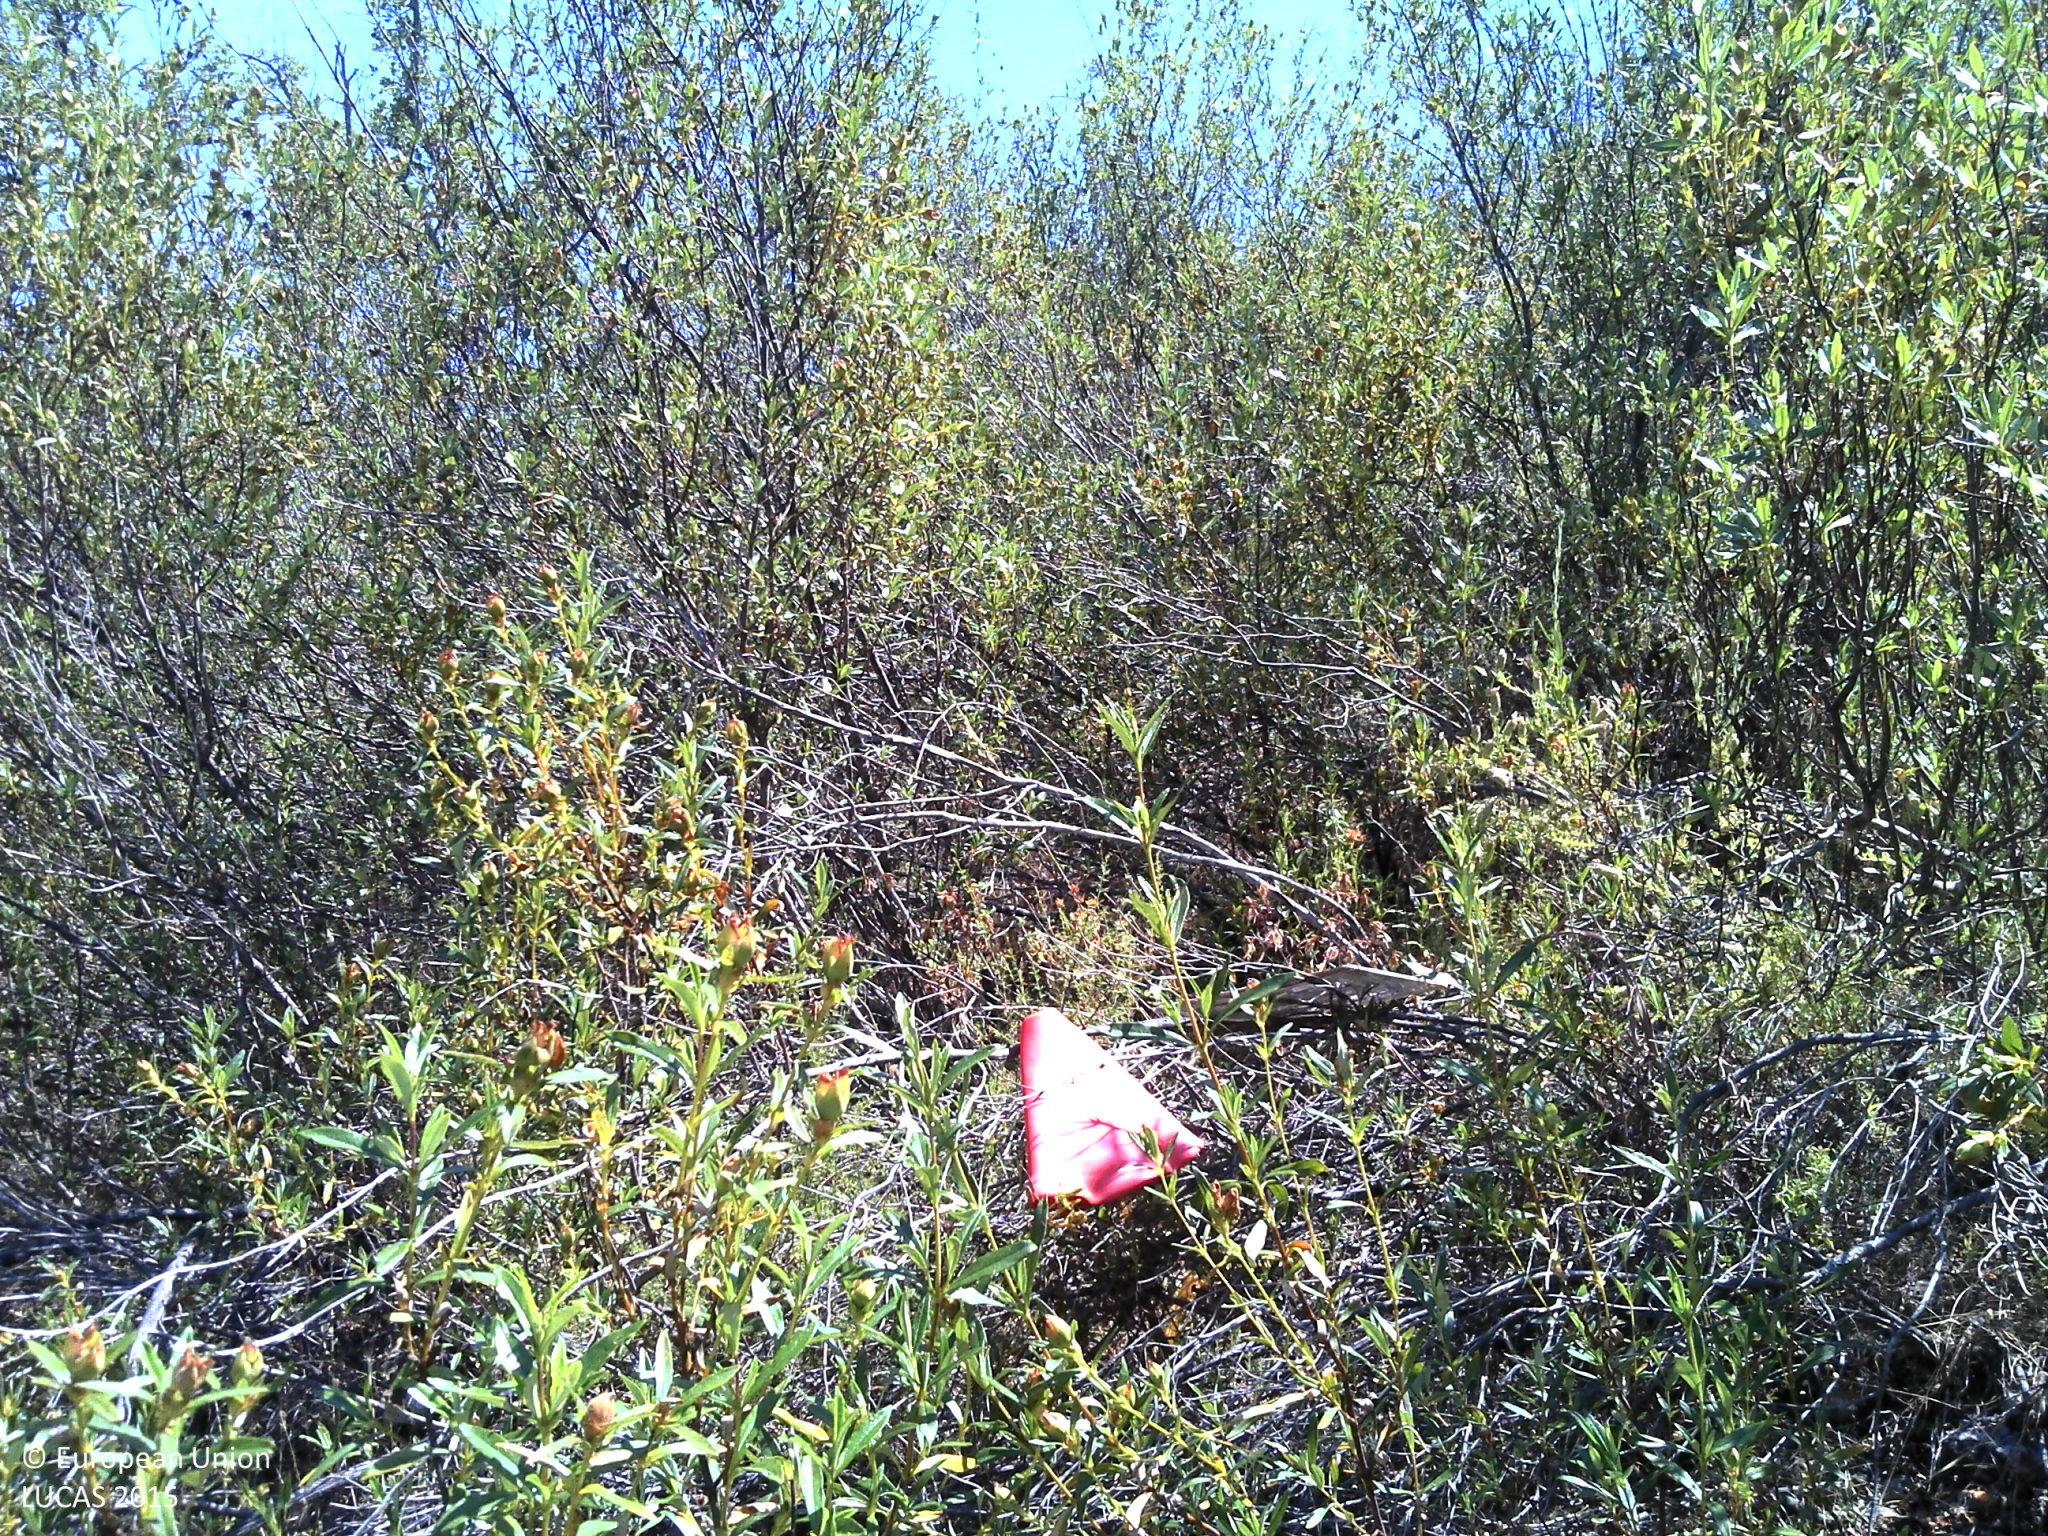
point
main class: Shrubland
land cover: Shrubland with sparse tree cover
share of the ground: 50 - 75 %
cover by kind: shrubs 75 %, unconsolidated bare surface 20 %, coniferous forest trees 5 %
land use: Forestry
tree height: > 5 m
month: June
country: PT
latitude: 37.7054
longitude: -8.5377
